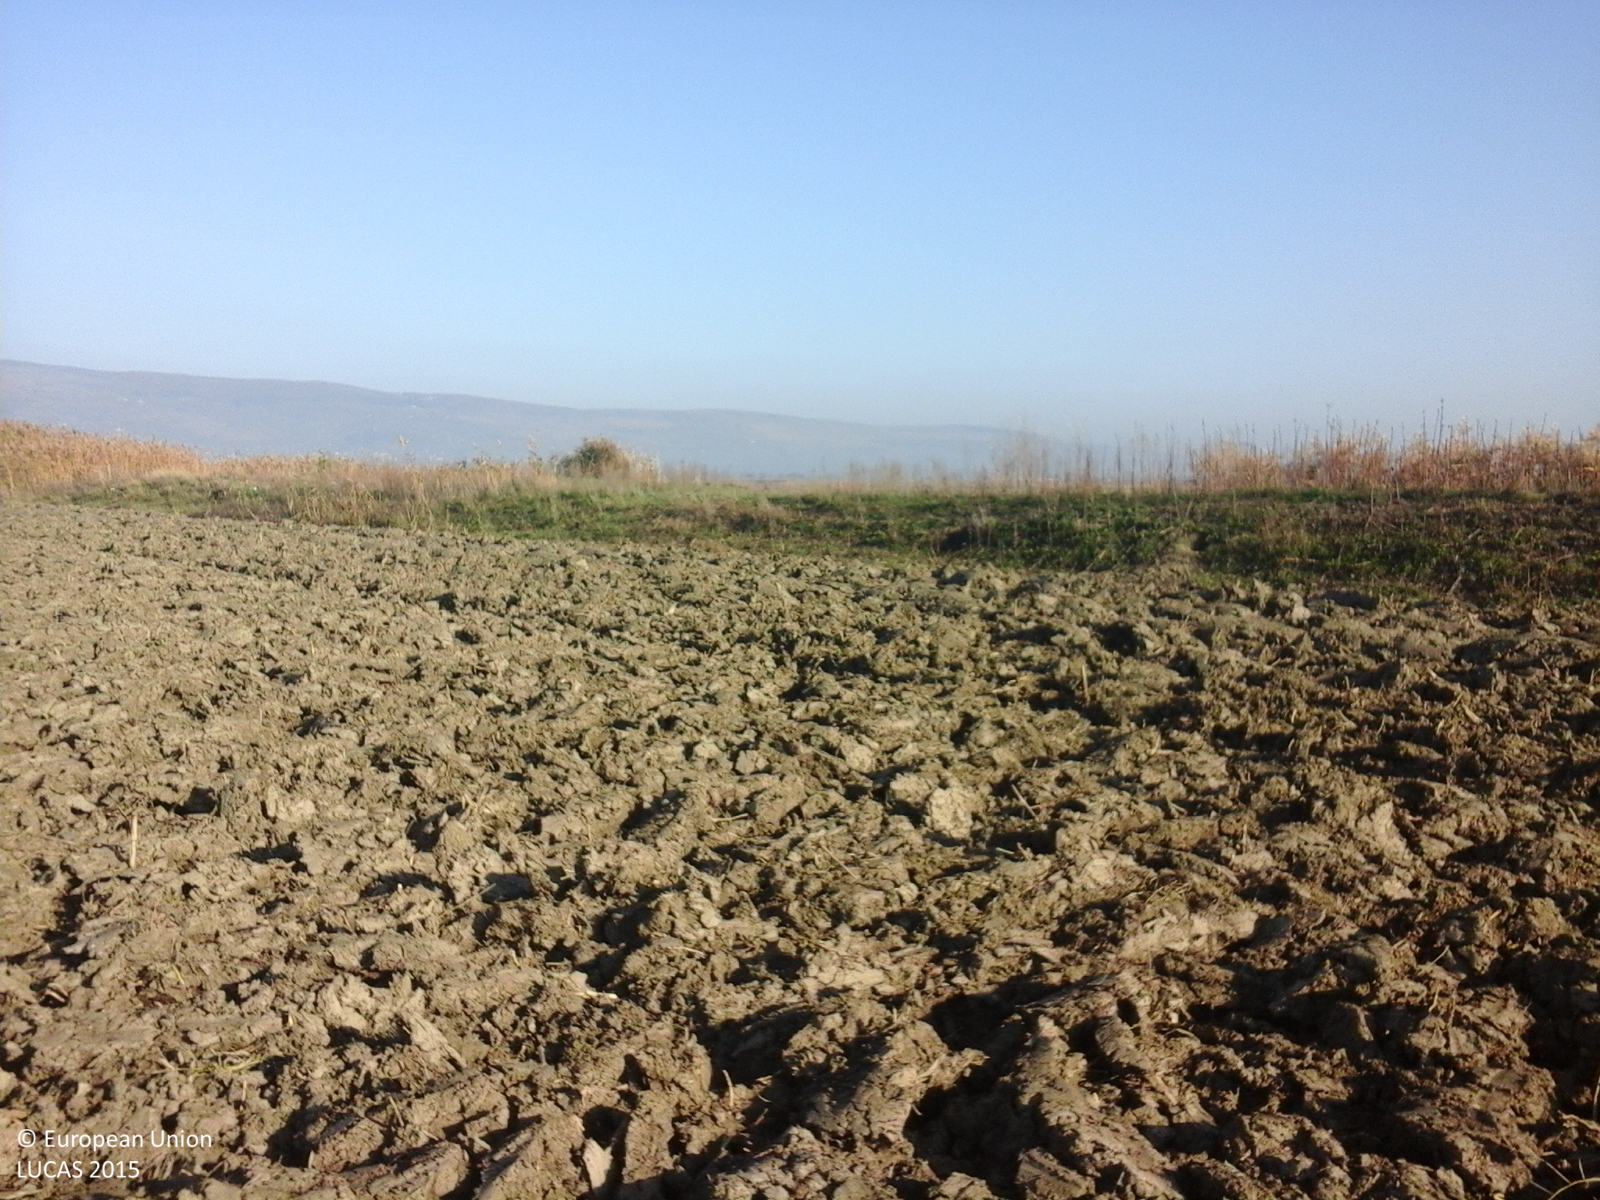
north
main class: Cropland
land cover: Maize
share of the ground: < 10 %
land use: Agriculture (excluding fallow land and kitchen gardens)
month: October
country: RO
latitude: 45.0441
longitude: 26.5897
